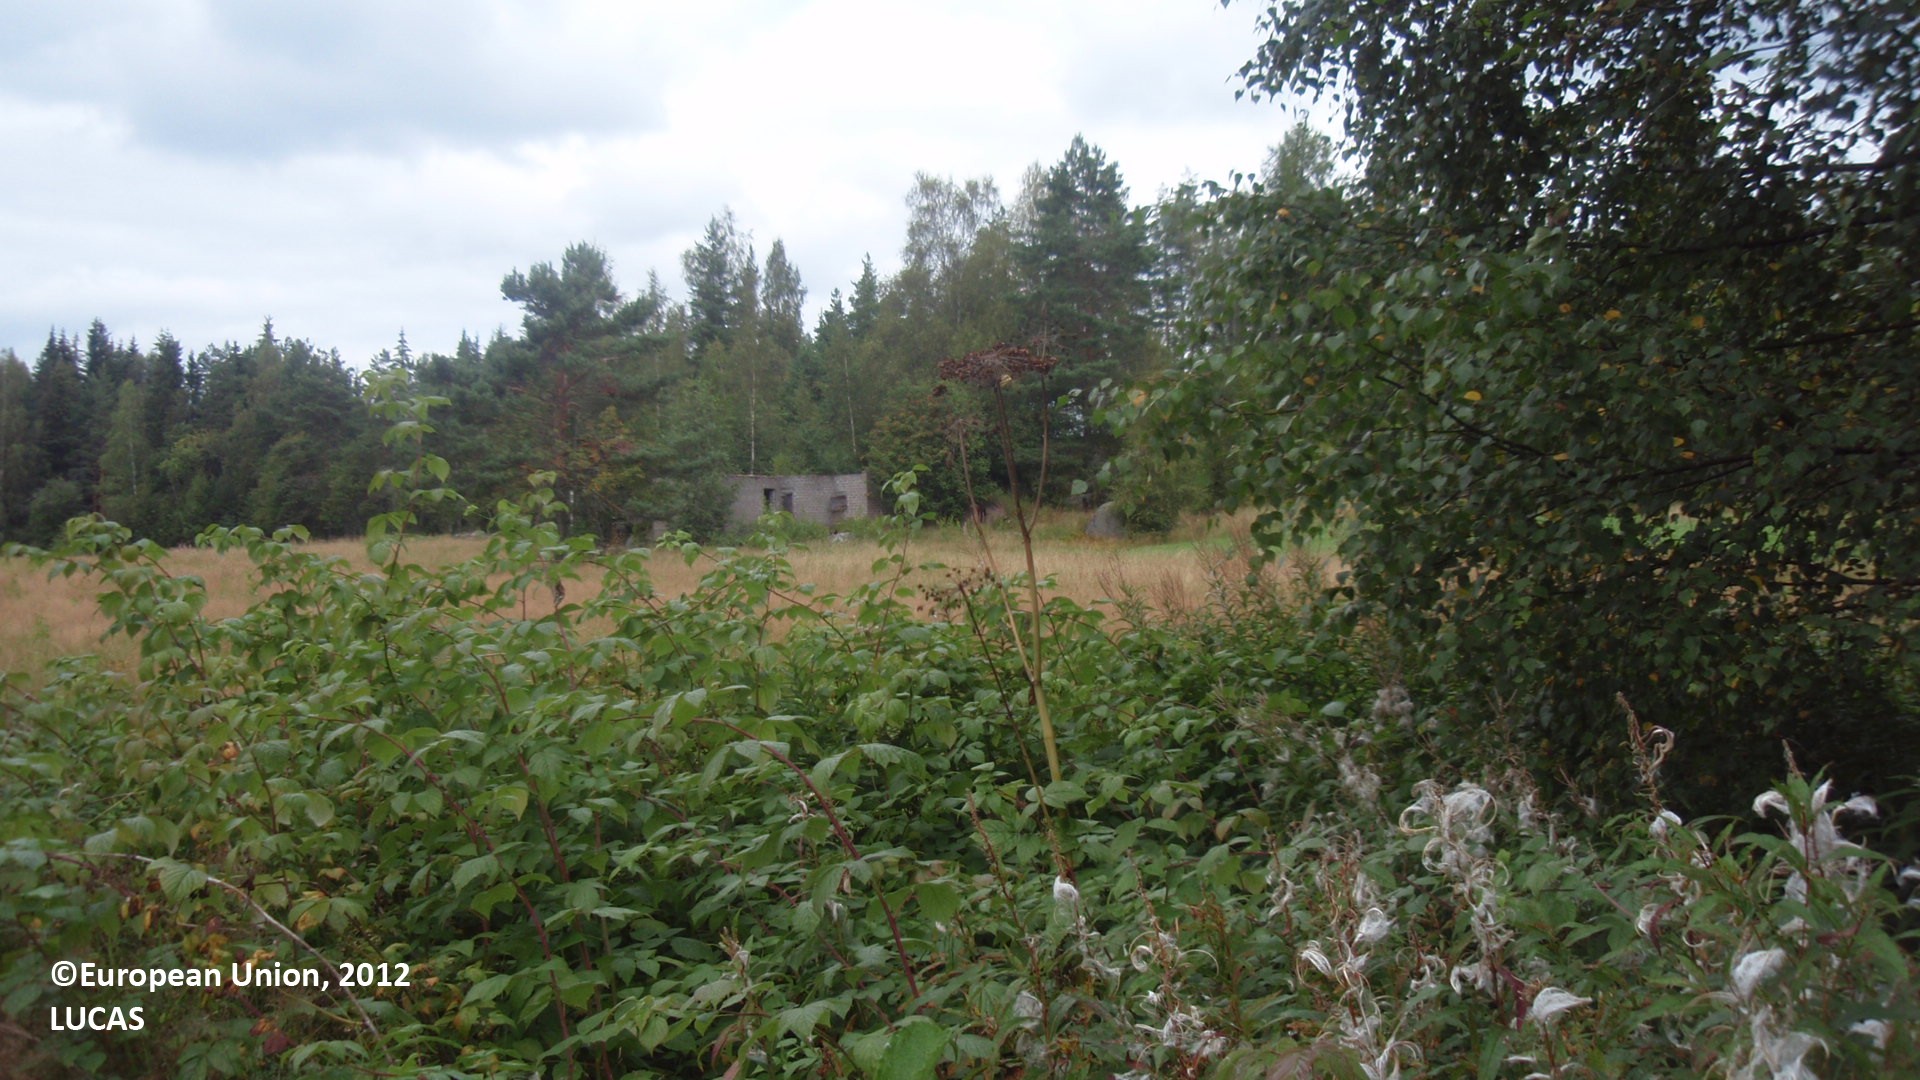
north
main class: Shrubland
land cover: Shrubland with sparse tree cover
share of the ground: > 75 %
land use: Agriculture (excluding fallow land and kitchen gardens)
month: August
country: FI
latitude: 60.8811
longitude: 27.4048
